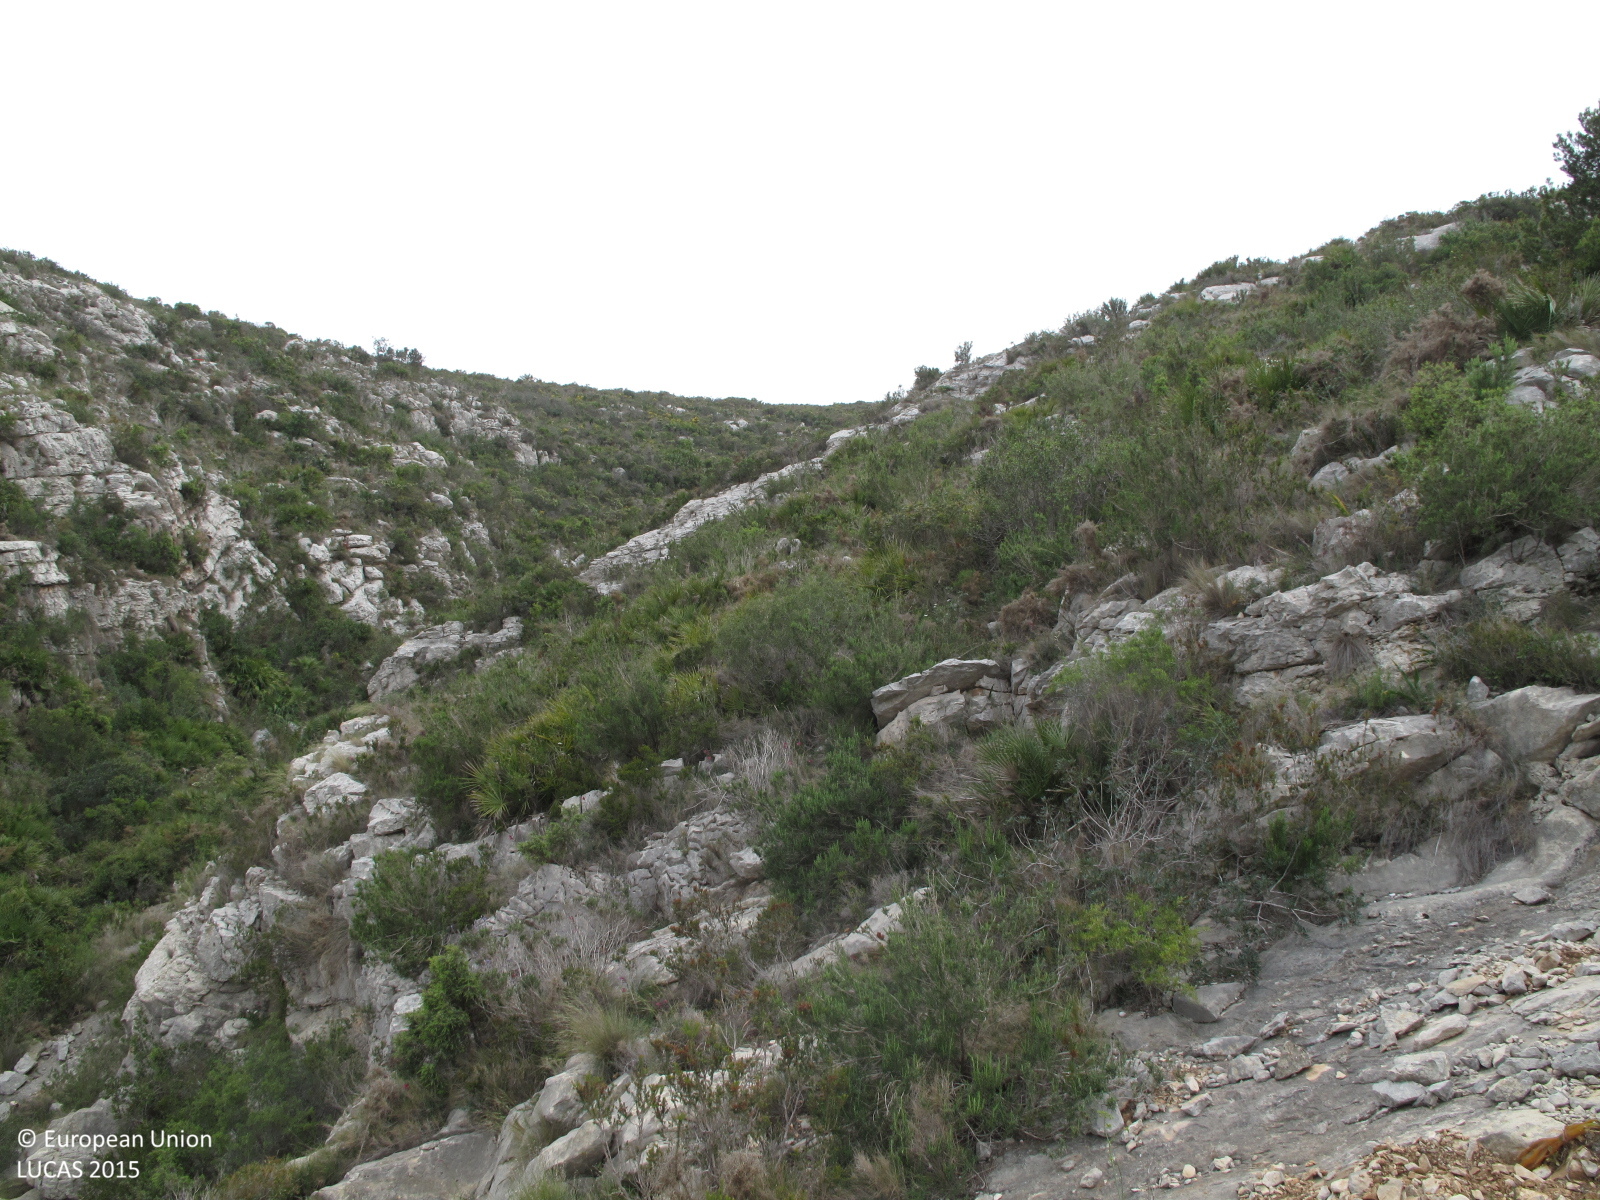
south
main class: Shrubland
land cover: Shrubland without tree cover
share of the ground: 25 - 50 %
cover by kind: shrubs 40 %, consolidated bare surface 40 %, herbaceous plants 20 %
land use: Semi-natural and natural areas not in use
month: April
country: ES
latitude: 38.8037
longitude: 0.1433
